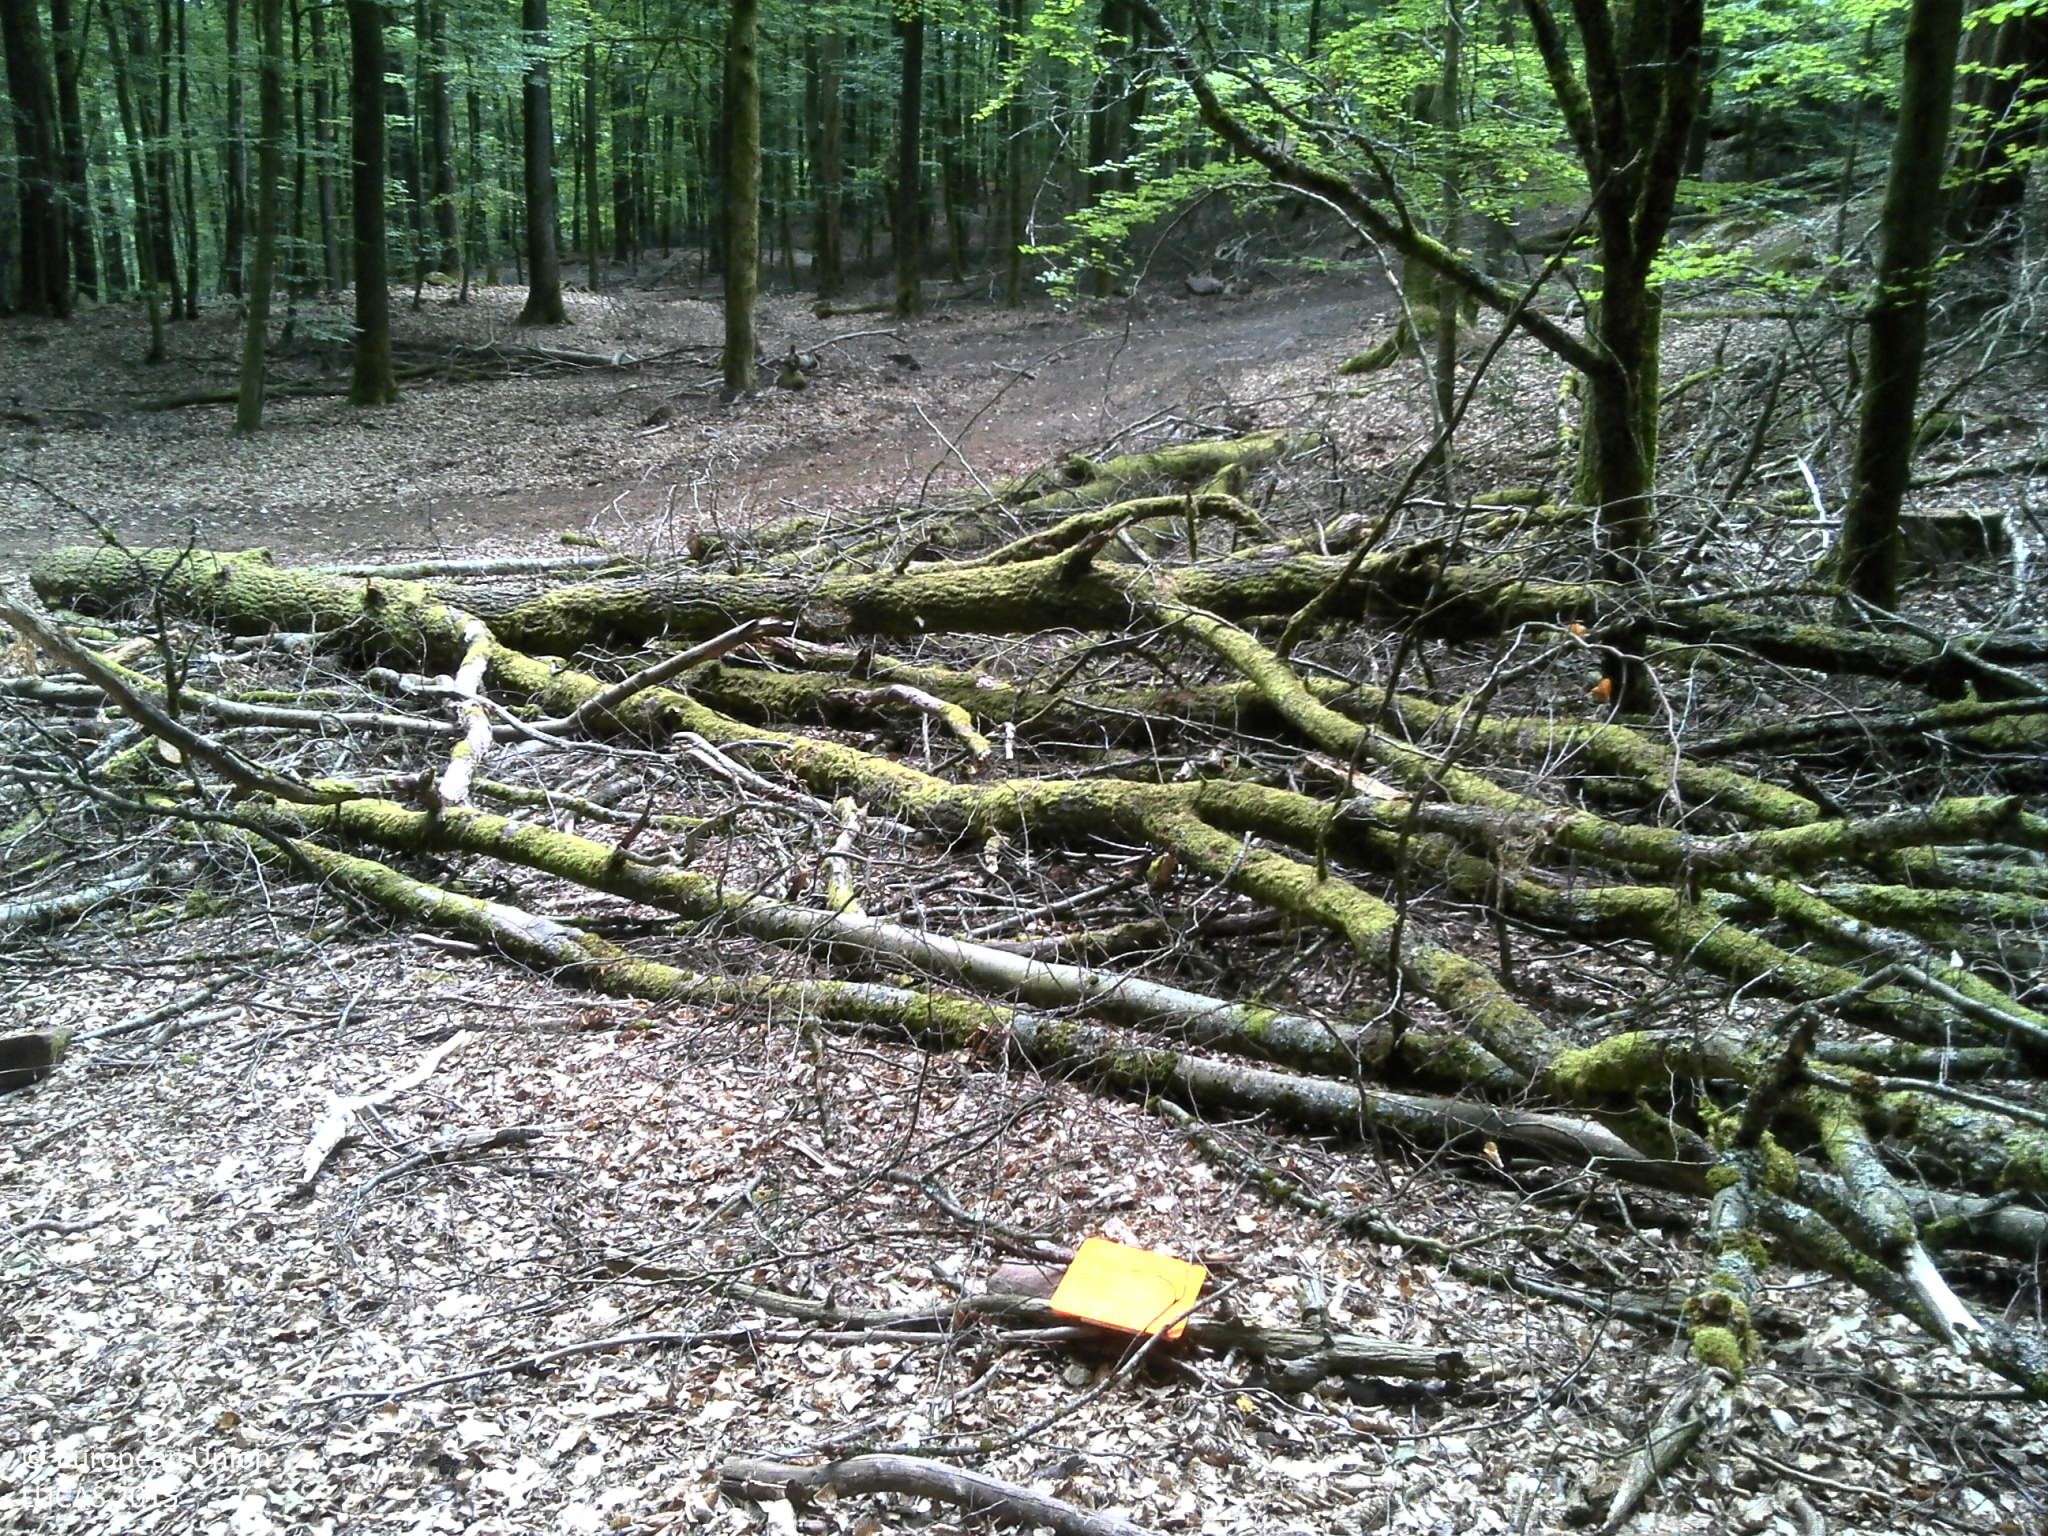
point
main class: Woodland
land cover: Broadleaved woodland
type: mesophytic deciduous forest
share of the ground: > 75 %
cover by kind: broadleaved forest trees 85 %, coniferous forest trees 5 %, lichens and mosses 5 %, unconsolidated bare surface 5 %
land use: Forestry
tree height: > 5 m
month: July
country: FR
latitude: 48.9866
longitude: 7.4725
